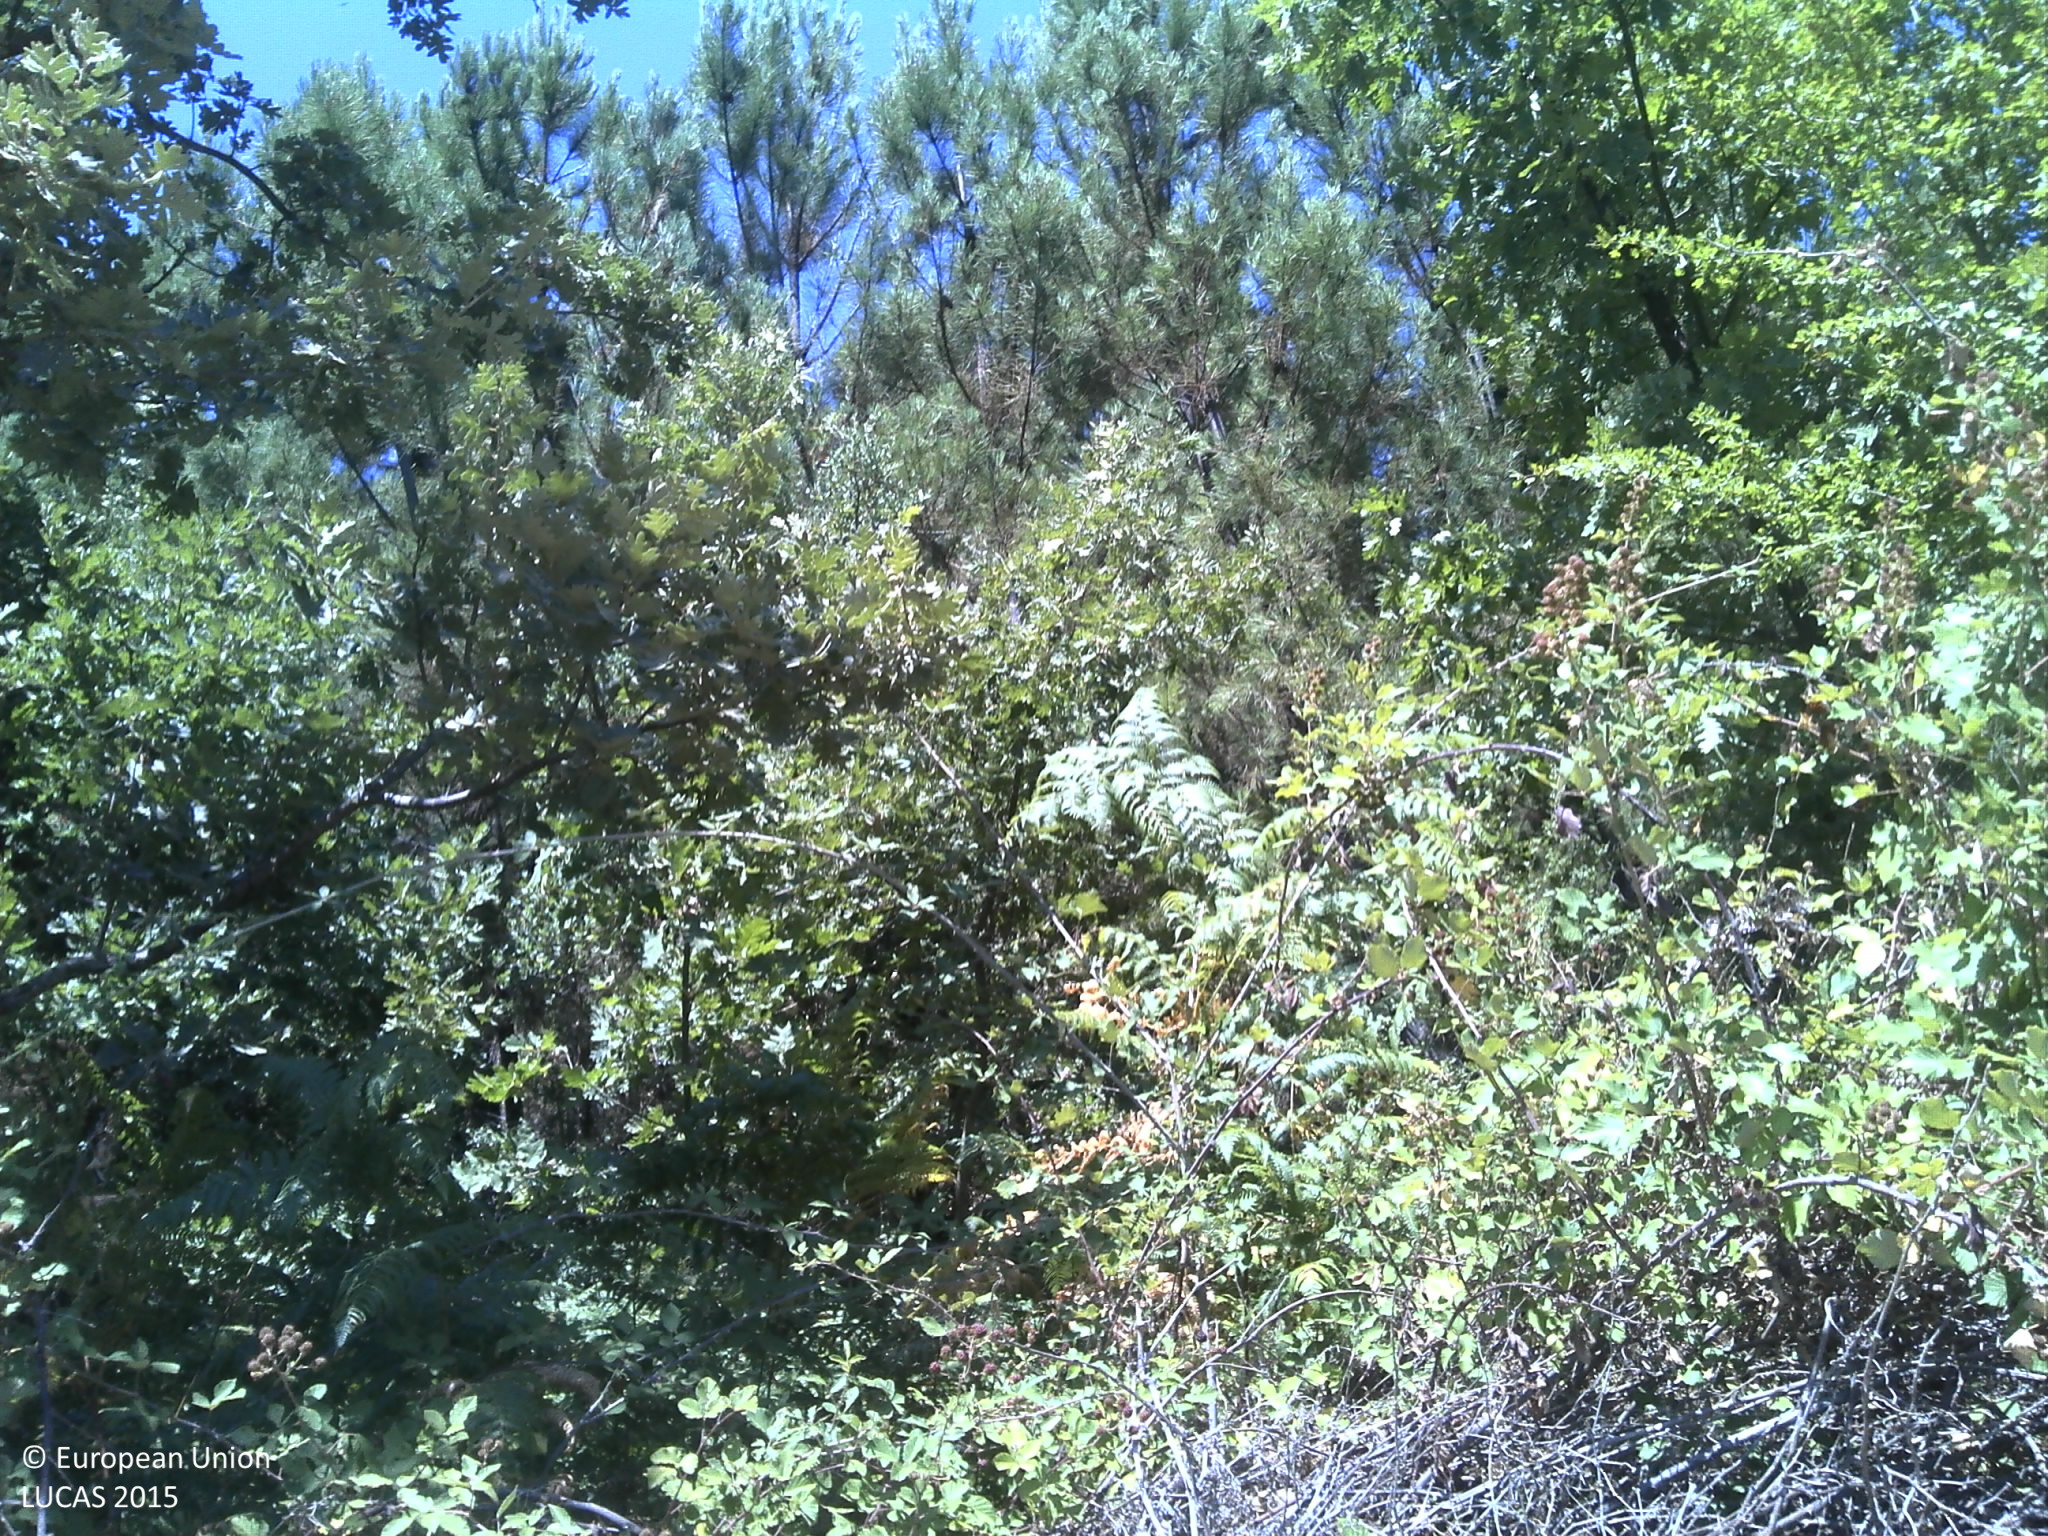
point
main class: Woodland
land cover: Pine dominated coniferous woodland
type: coniferous forest of the mediterranean region
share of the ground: 25 - 50 %
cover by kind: coniferous forest trees 50 %, shrubs 35 %, unconsolidated bare surface 10 %
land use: Forestry
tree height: > 5 m
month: July
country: PT
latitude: 40.3983
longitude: -7.3907
